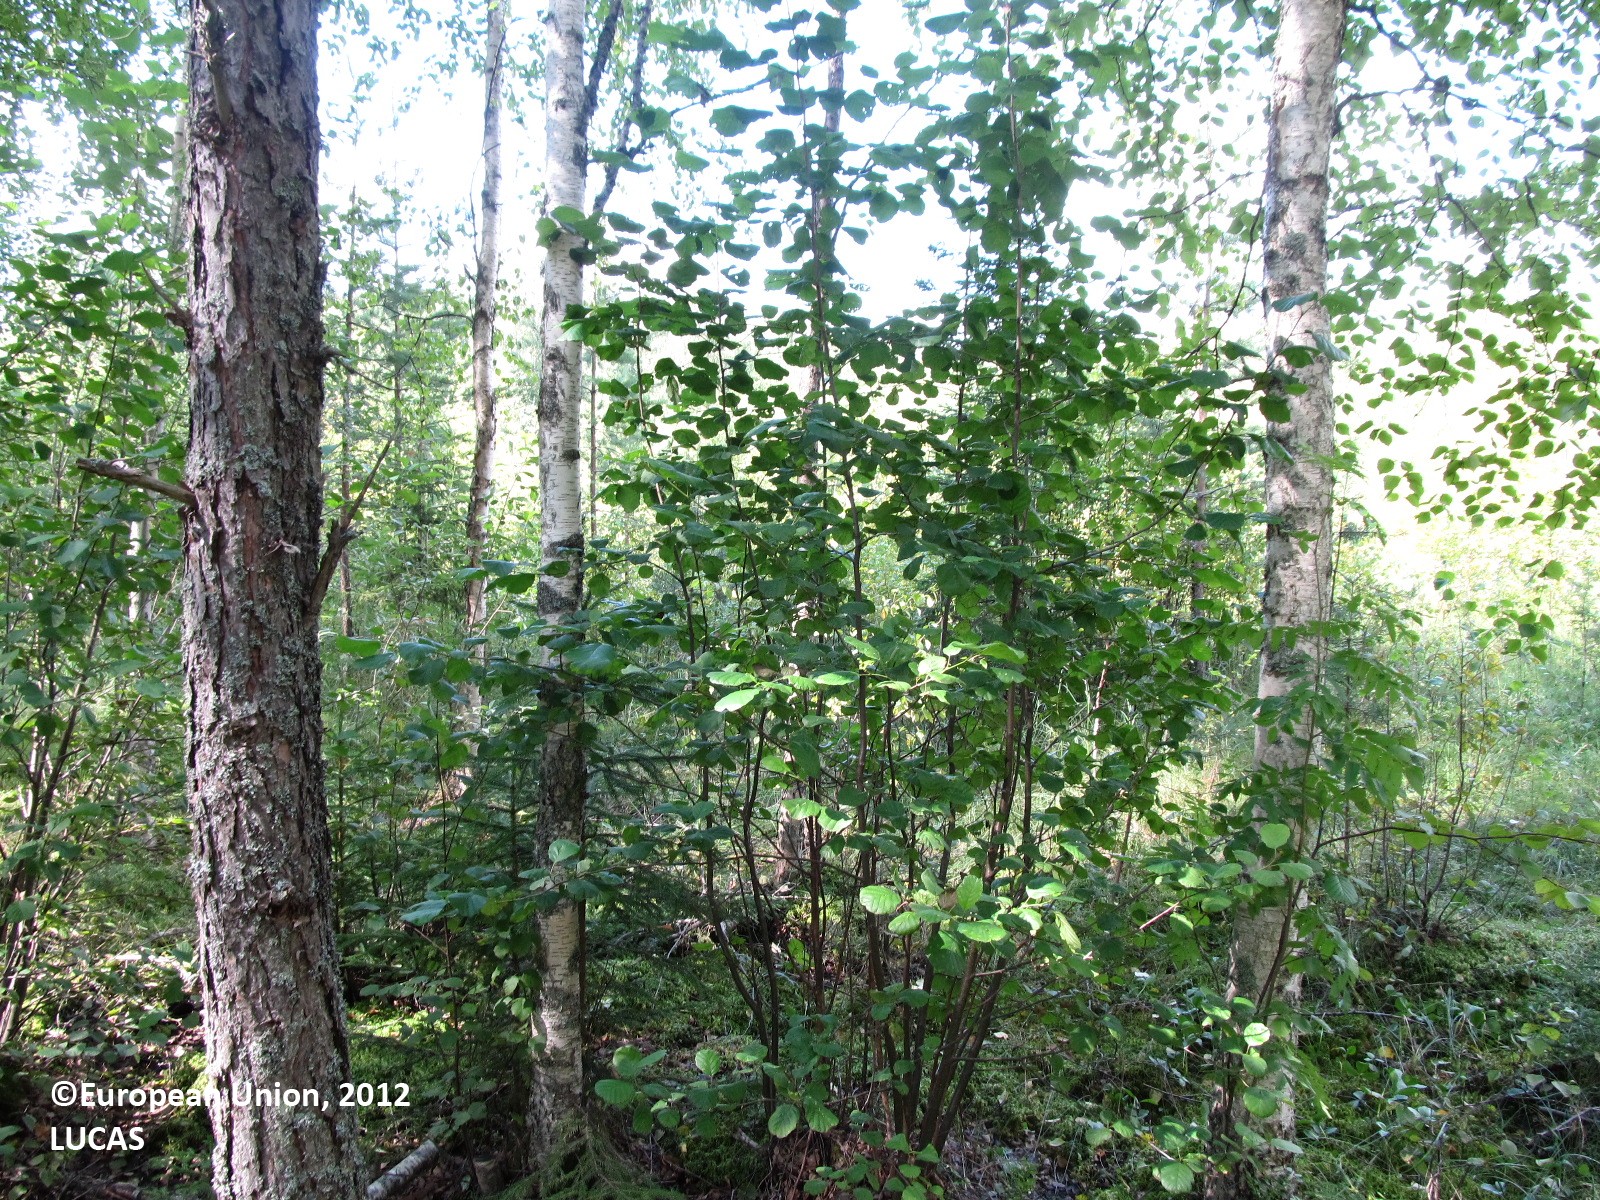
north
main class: Woodland
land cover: Pine dominated mixed woodland
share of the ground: 25 - 50 %
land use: Forestry
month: July
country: FI
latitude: 62.0858
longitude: 28.1738
